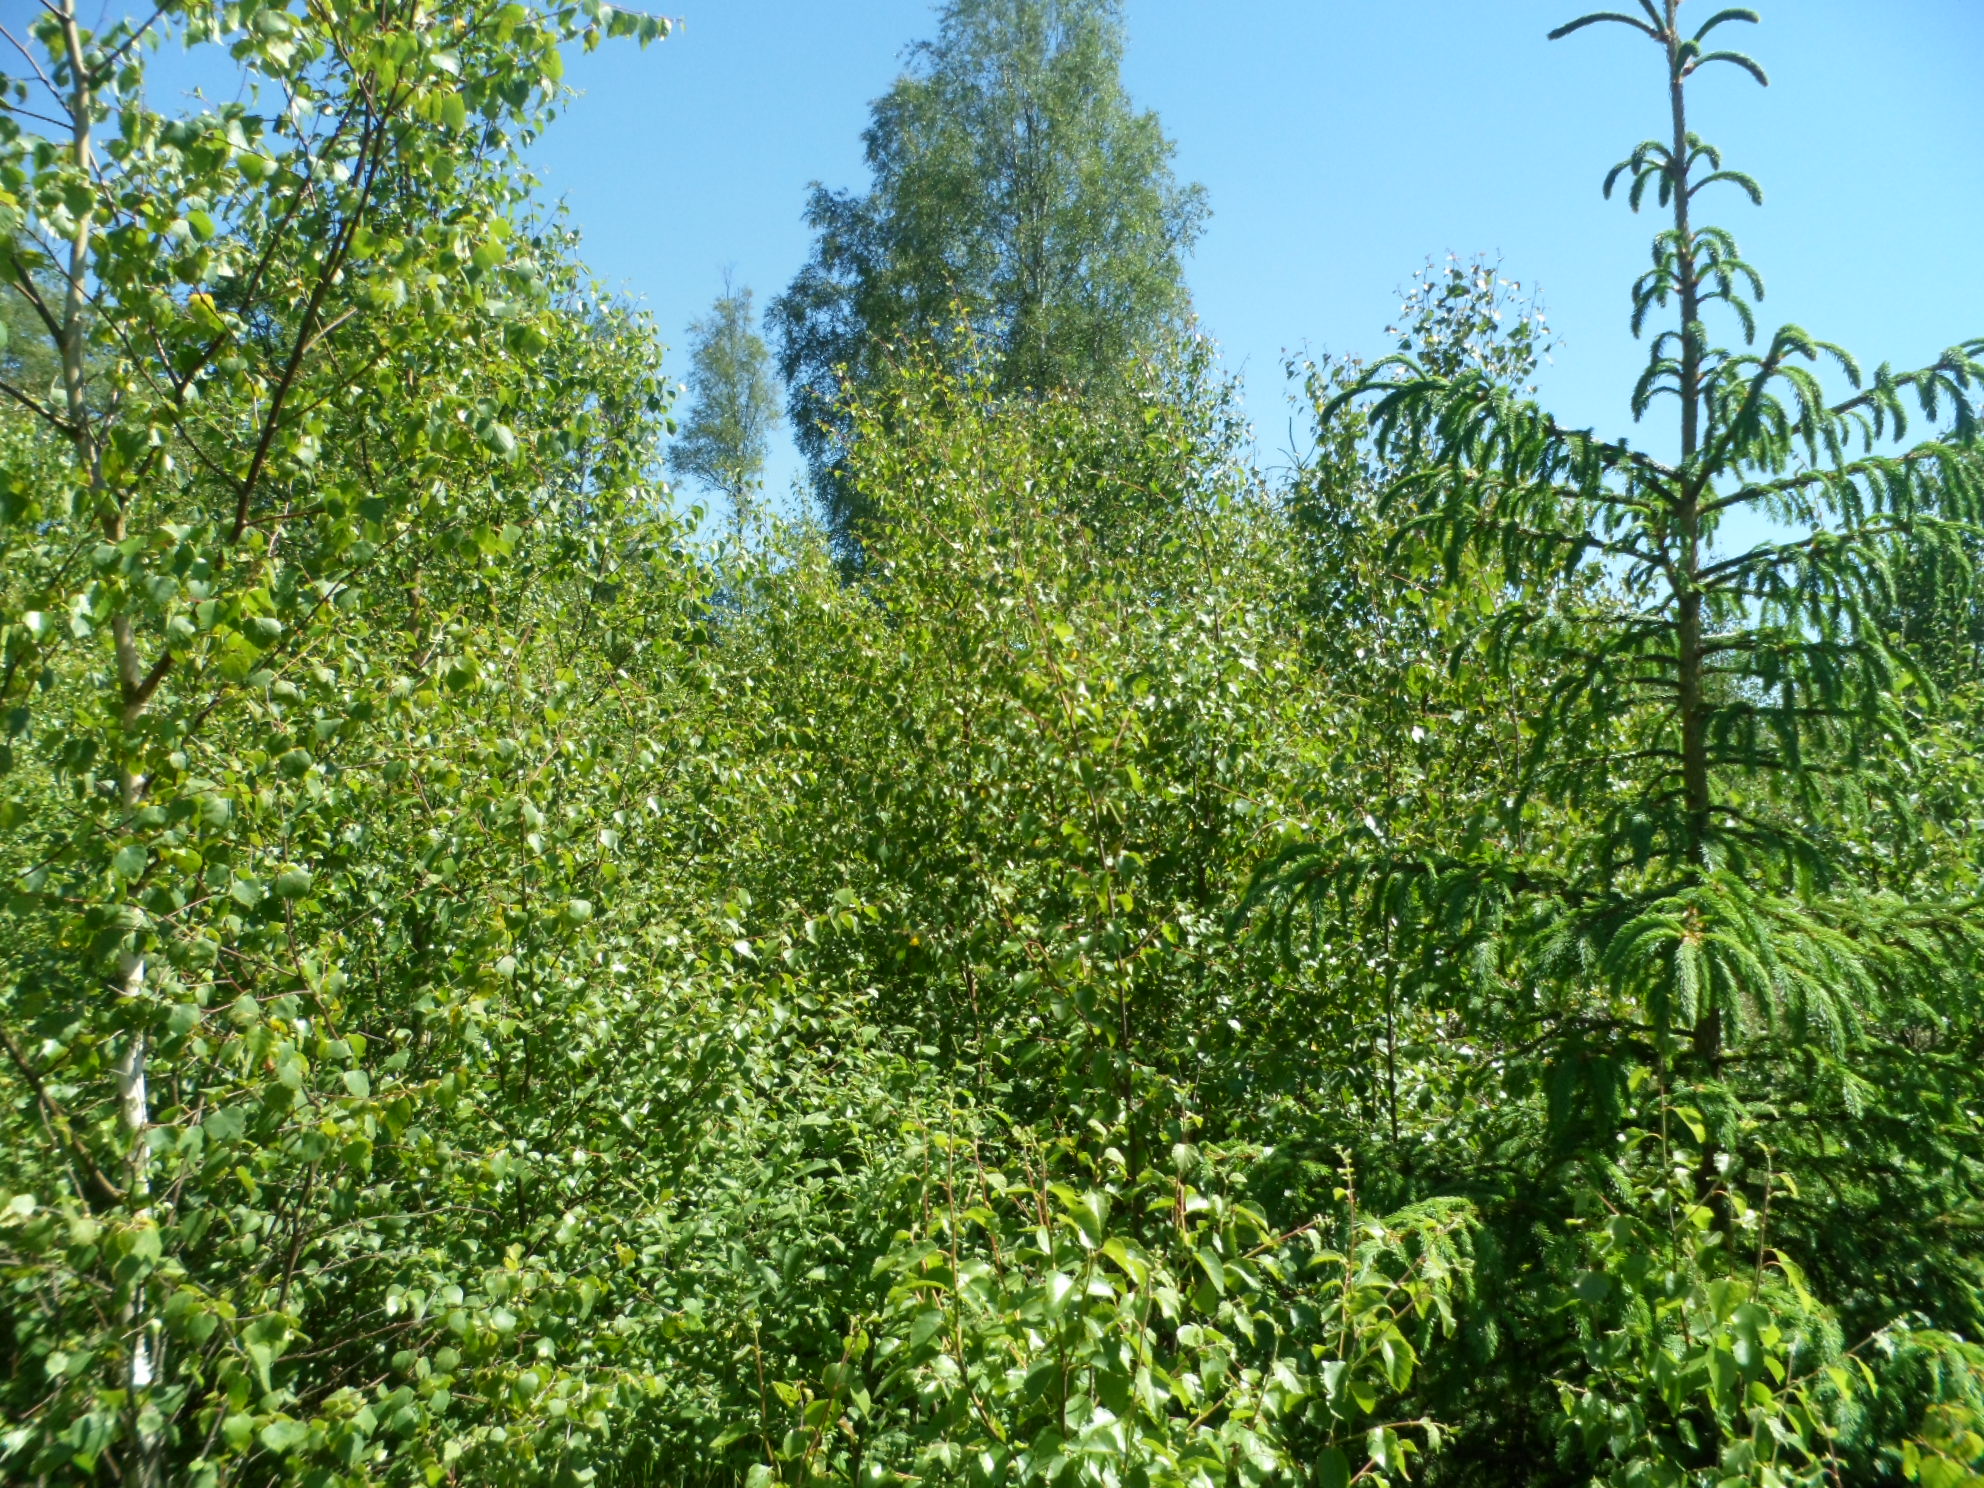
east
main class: Woodland
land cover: Spruce dominated mixed woodland
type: boreal forest
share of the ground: > 75 %
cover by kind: broadleaved forest trees 55 %, coniferous forest trees 35 %, herbaceous plants 10 %
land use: Forestry
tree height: < 5 m
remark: Clear cut
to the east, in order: Spruce dominated mixed woodland; Ditches and canals; Broadleaved woodland; Ditches and canals; Grassland with sparse tree/shrub cover; Paved roads, cycling and walking lanes; Broadleaved woodland; Dry stone walls; Broadleaved woodland; Fences; Grassland with sparse tree/shrub cover; Fences; Dry stone walls; Paved roads, cycling and walking lanes; Grassland without tree/shrub cover; Fences; Groves; Fences; Grassland without tree/shrub cover
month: July
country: SE
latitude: 57.1329
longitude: 14.5729
